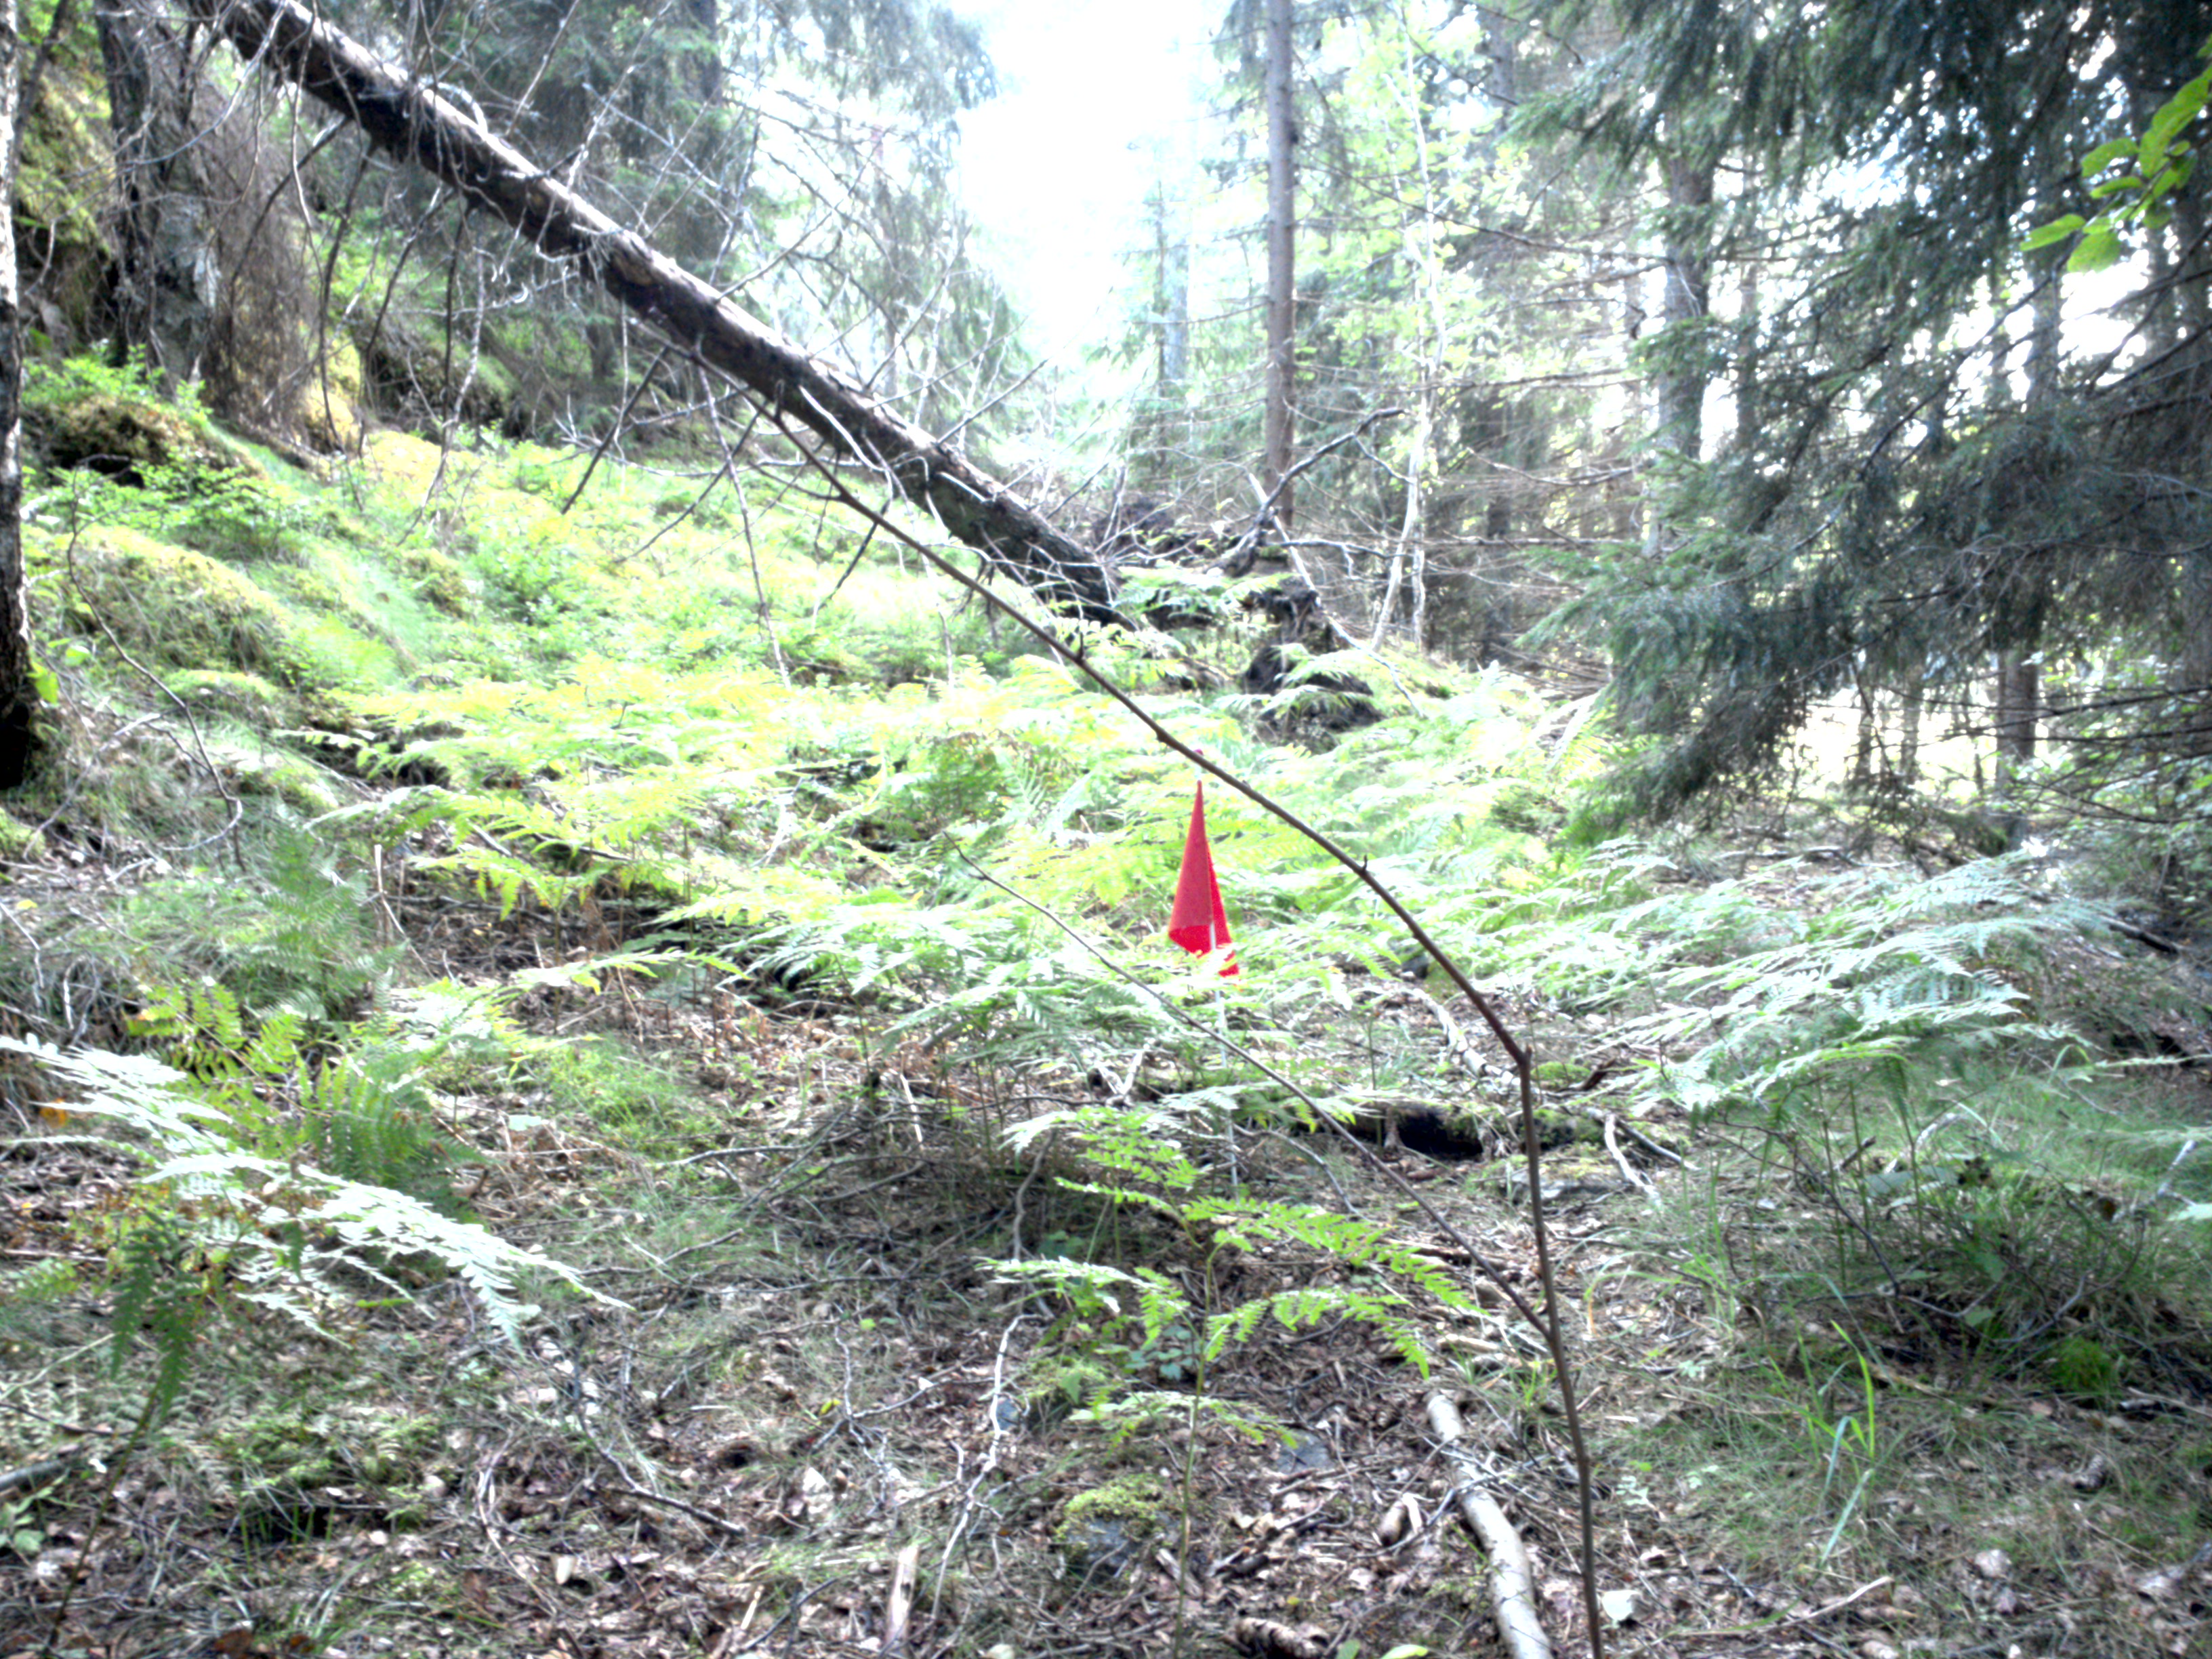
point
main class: Woodland
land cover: Spruce dominated coniferous woodland
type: boreal forest
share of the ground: > 75 %
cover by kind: coniferous forest trees 60 %, broadleaved forest trees 15 %, lichens and mosses 15 %, shrubs 10 %
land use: Forestry
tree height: > 5 m
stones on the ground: 10 - 25 %
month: July
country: SE
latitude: 59.0875
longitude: 18.2554
